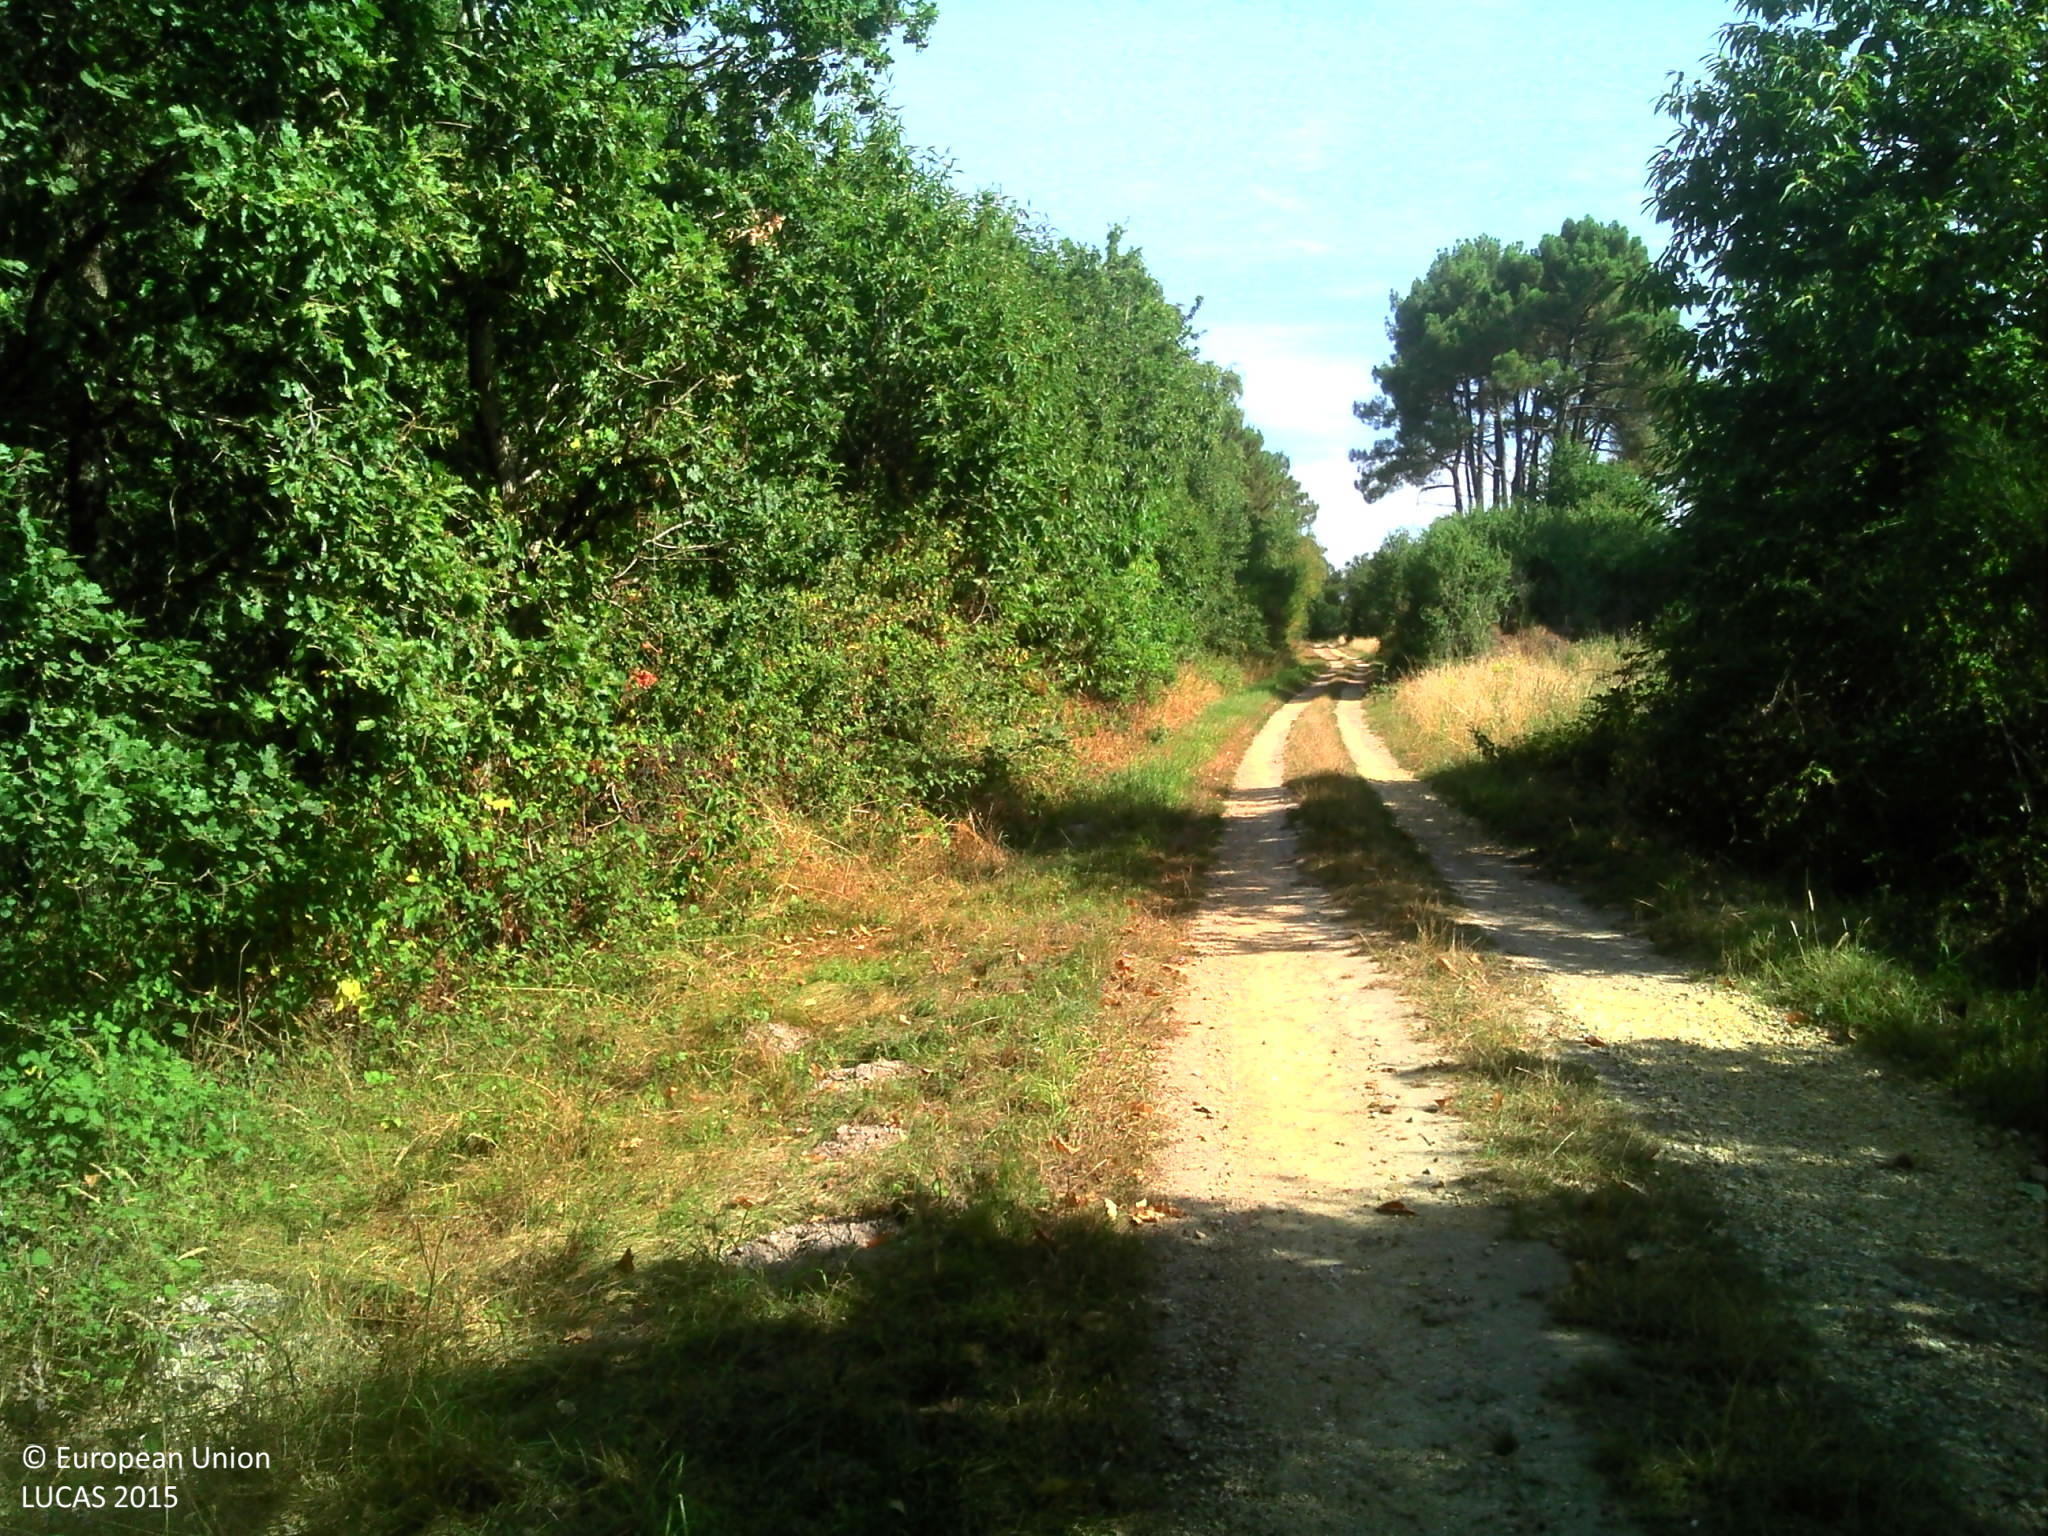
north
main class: Woodland
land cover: Pine dominated mixed woodland
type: mesophytic deciduous forest
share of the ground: > 75 %
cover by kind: broadleaved forest trees 50 %, coniferous forest trees 25 %, shrubs 10 %, herbaceous plants 10 %, lichens and mosses 5 %
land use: Forestry
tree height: > 5 m
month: July
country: FR
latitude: 47.0660
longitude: 0.4599
